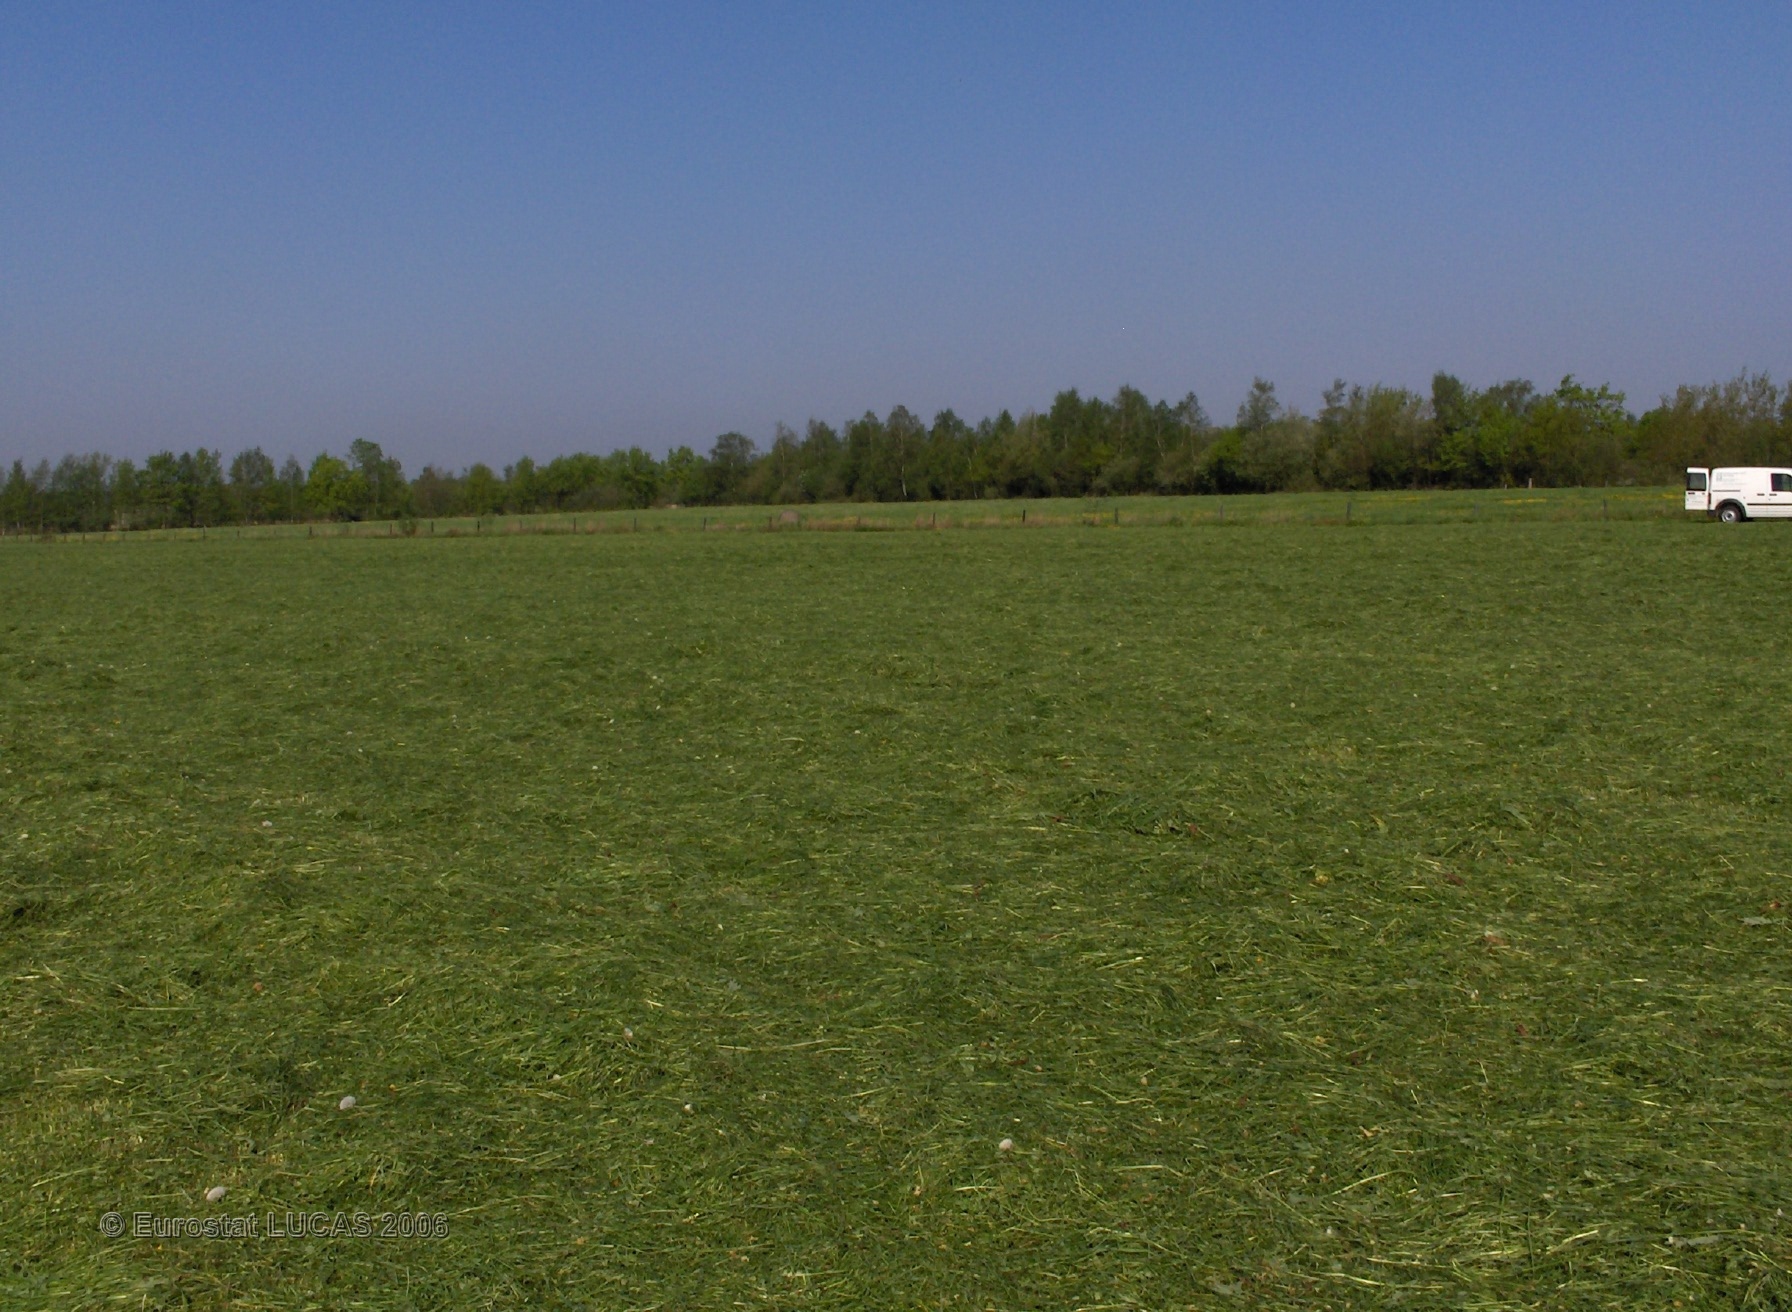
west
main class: Grassland
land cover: Grassland without tree/shrub cover
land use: Agriculture (excluding fallow land and kitchen gardens)
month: May
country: BE
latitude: 51.2874
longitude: 5.1366
